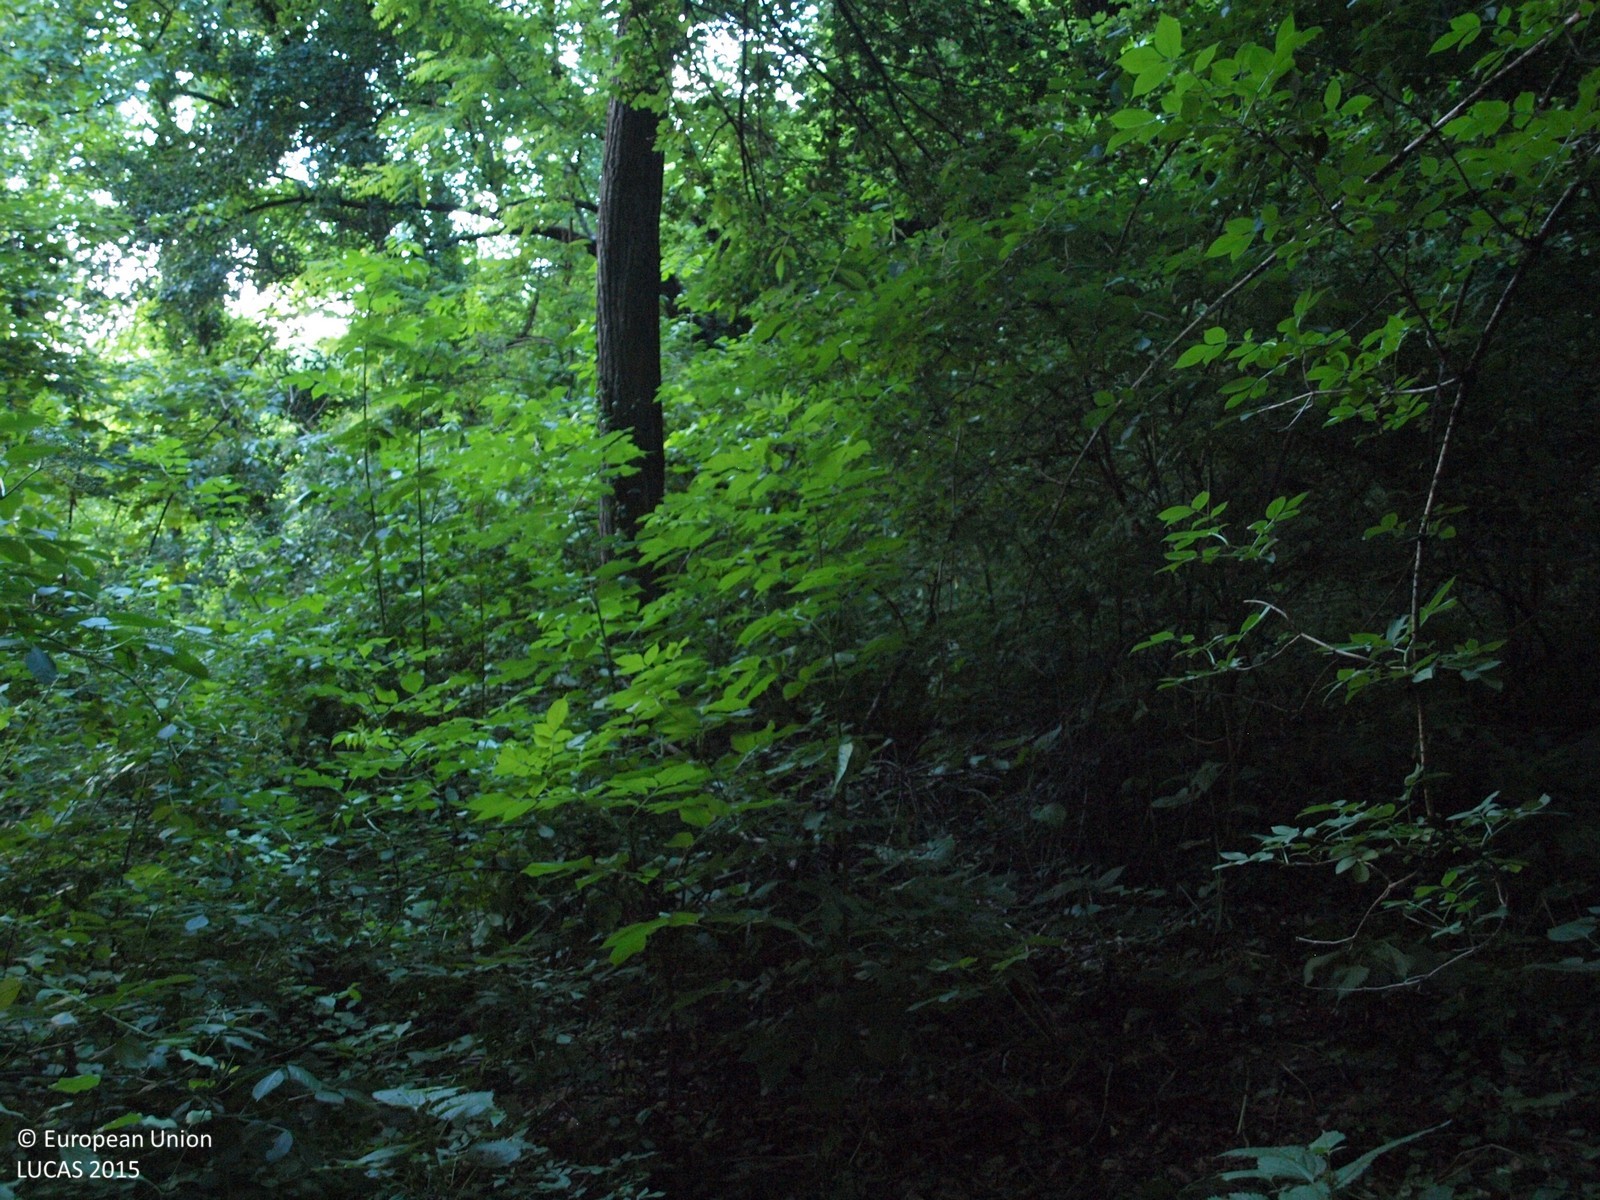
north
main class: Woodland
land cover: Broadleaved woodland
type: mesophytic deciduous forest
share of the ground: > 75 %
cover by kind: broadleaved forest trees 100 %
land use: Forestry
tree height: > 5 m
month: June
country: HR
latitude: 46.0162
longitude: 15.7457
